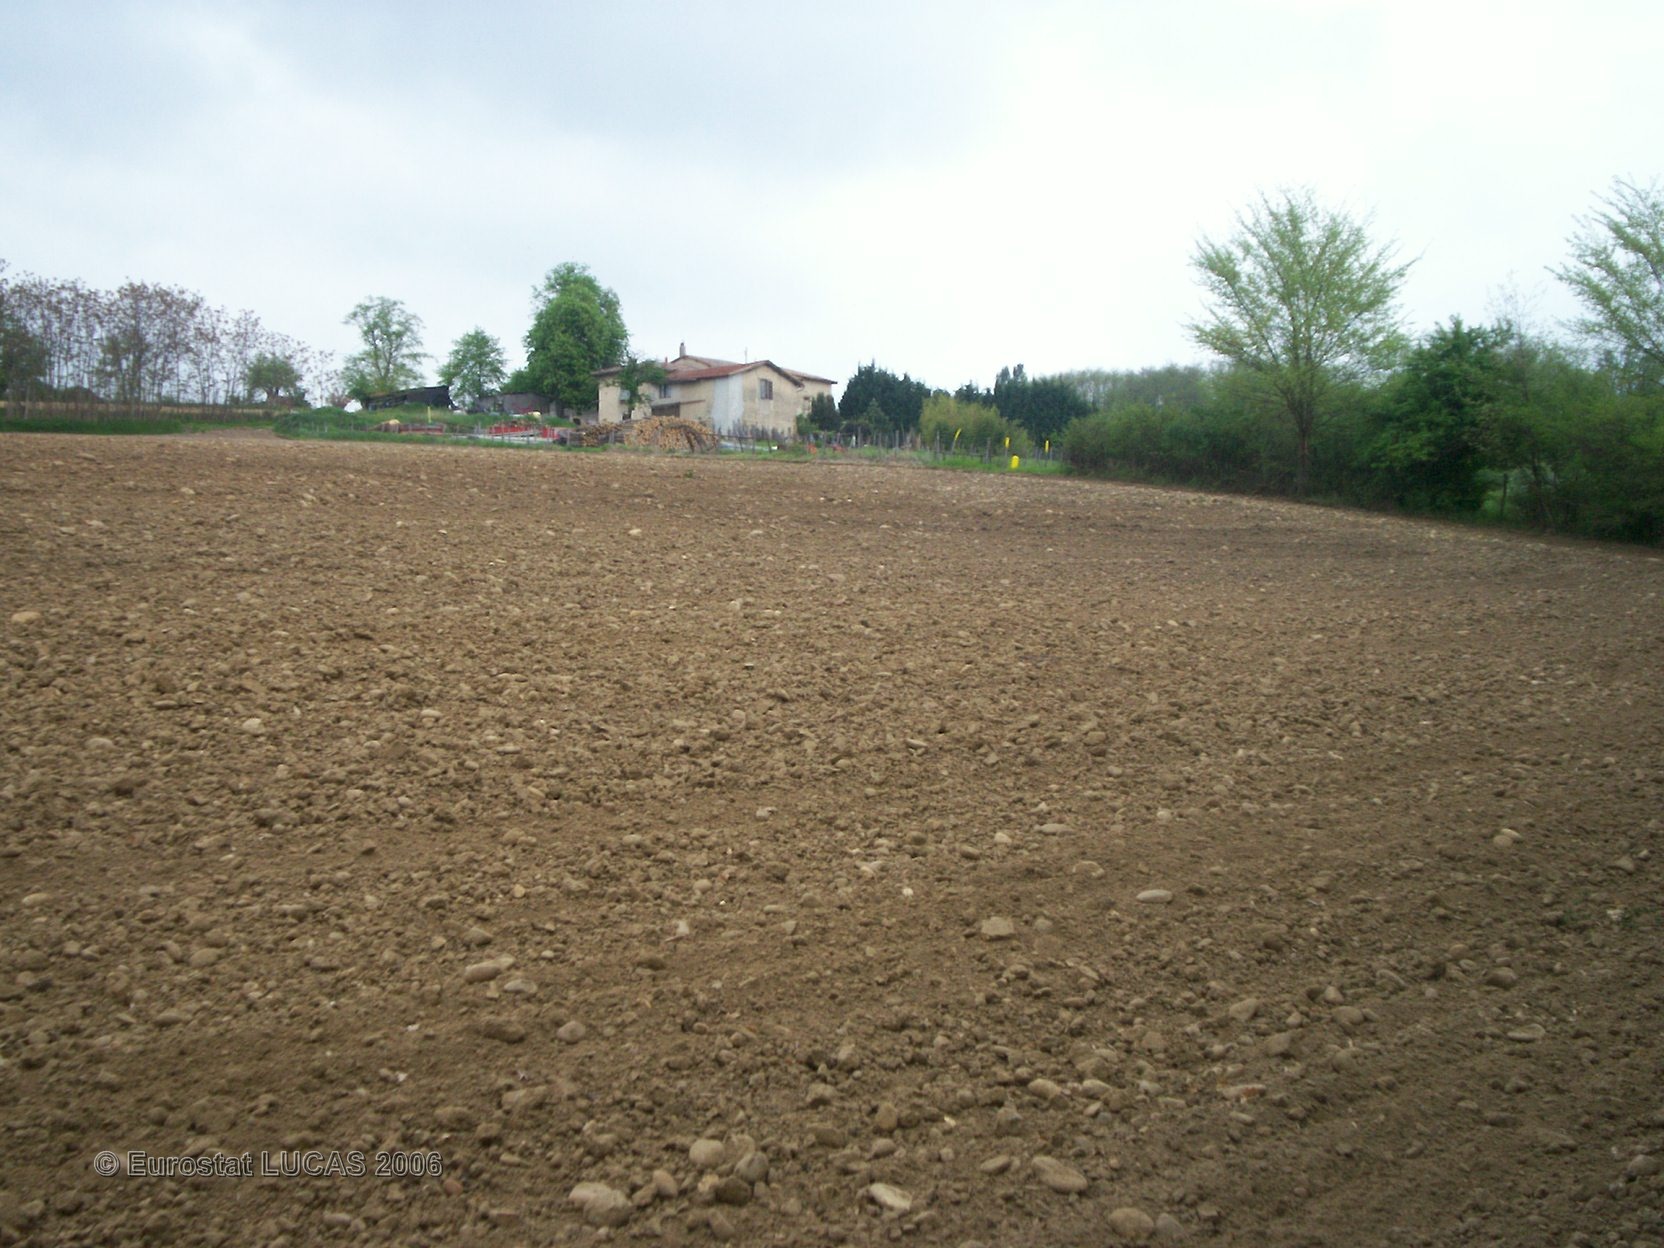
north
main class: Cropland
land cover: Maize
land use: Agriculture (excluding fallow land and kitchen gardens)
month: June
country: FR
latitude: 45.3599
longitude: 4.8343
